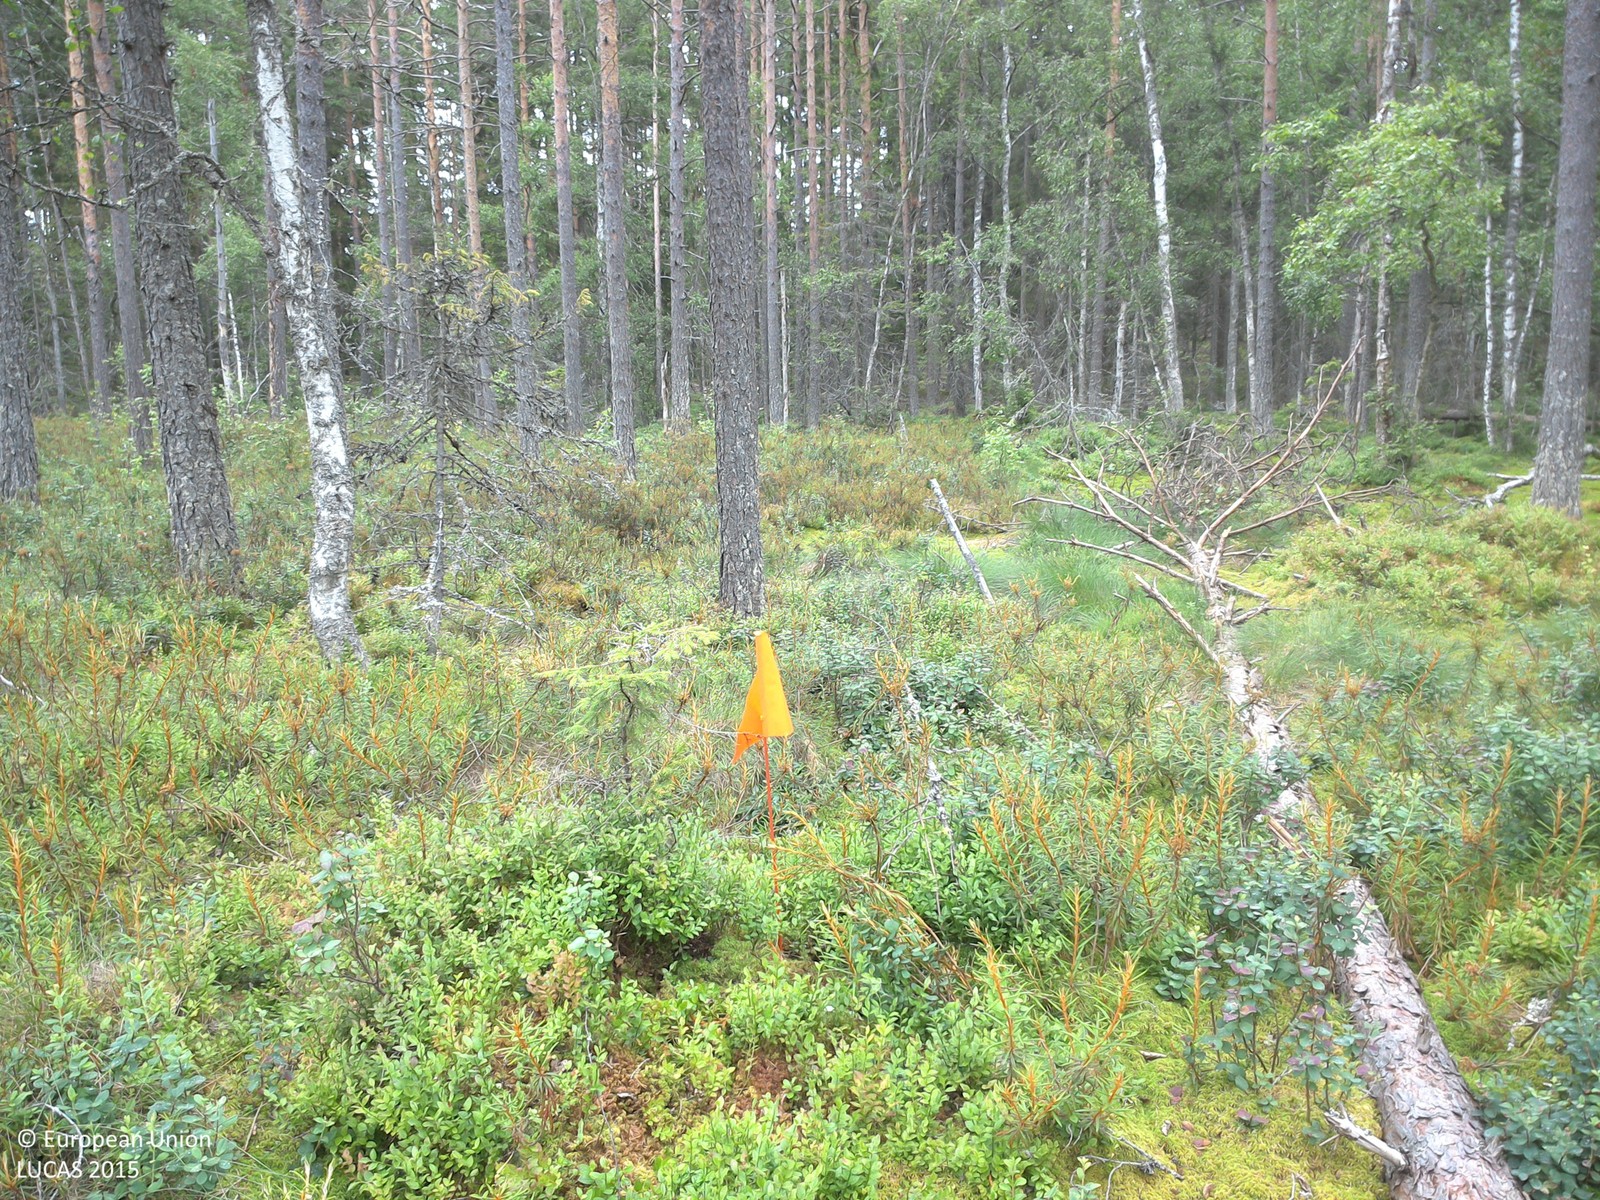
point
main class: Woodland
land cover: Pine dominated coniferous woodland
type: boreal forest
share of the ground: 25 - 50 %
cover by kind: coniferous forest trees 50 %, shrubs 40 %, herbaceous plants 5 %, lichens and mosses 5 %
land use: Forestry
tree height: > 5 m
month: July
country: SE
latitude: 57.7236
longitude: 16.0249
